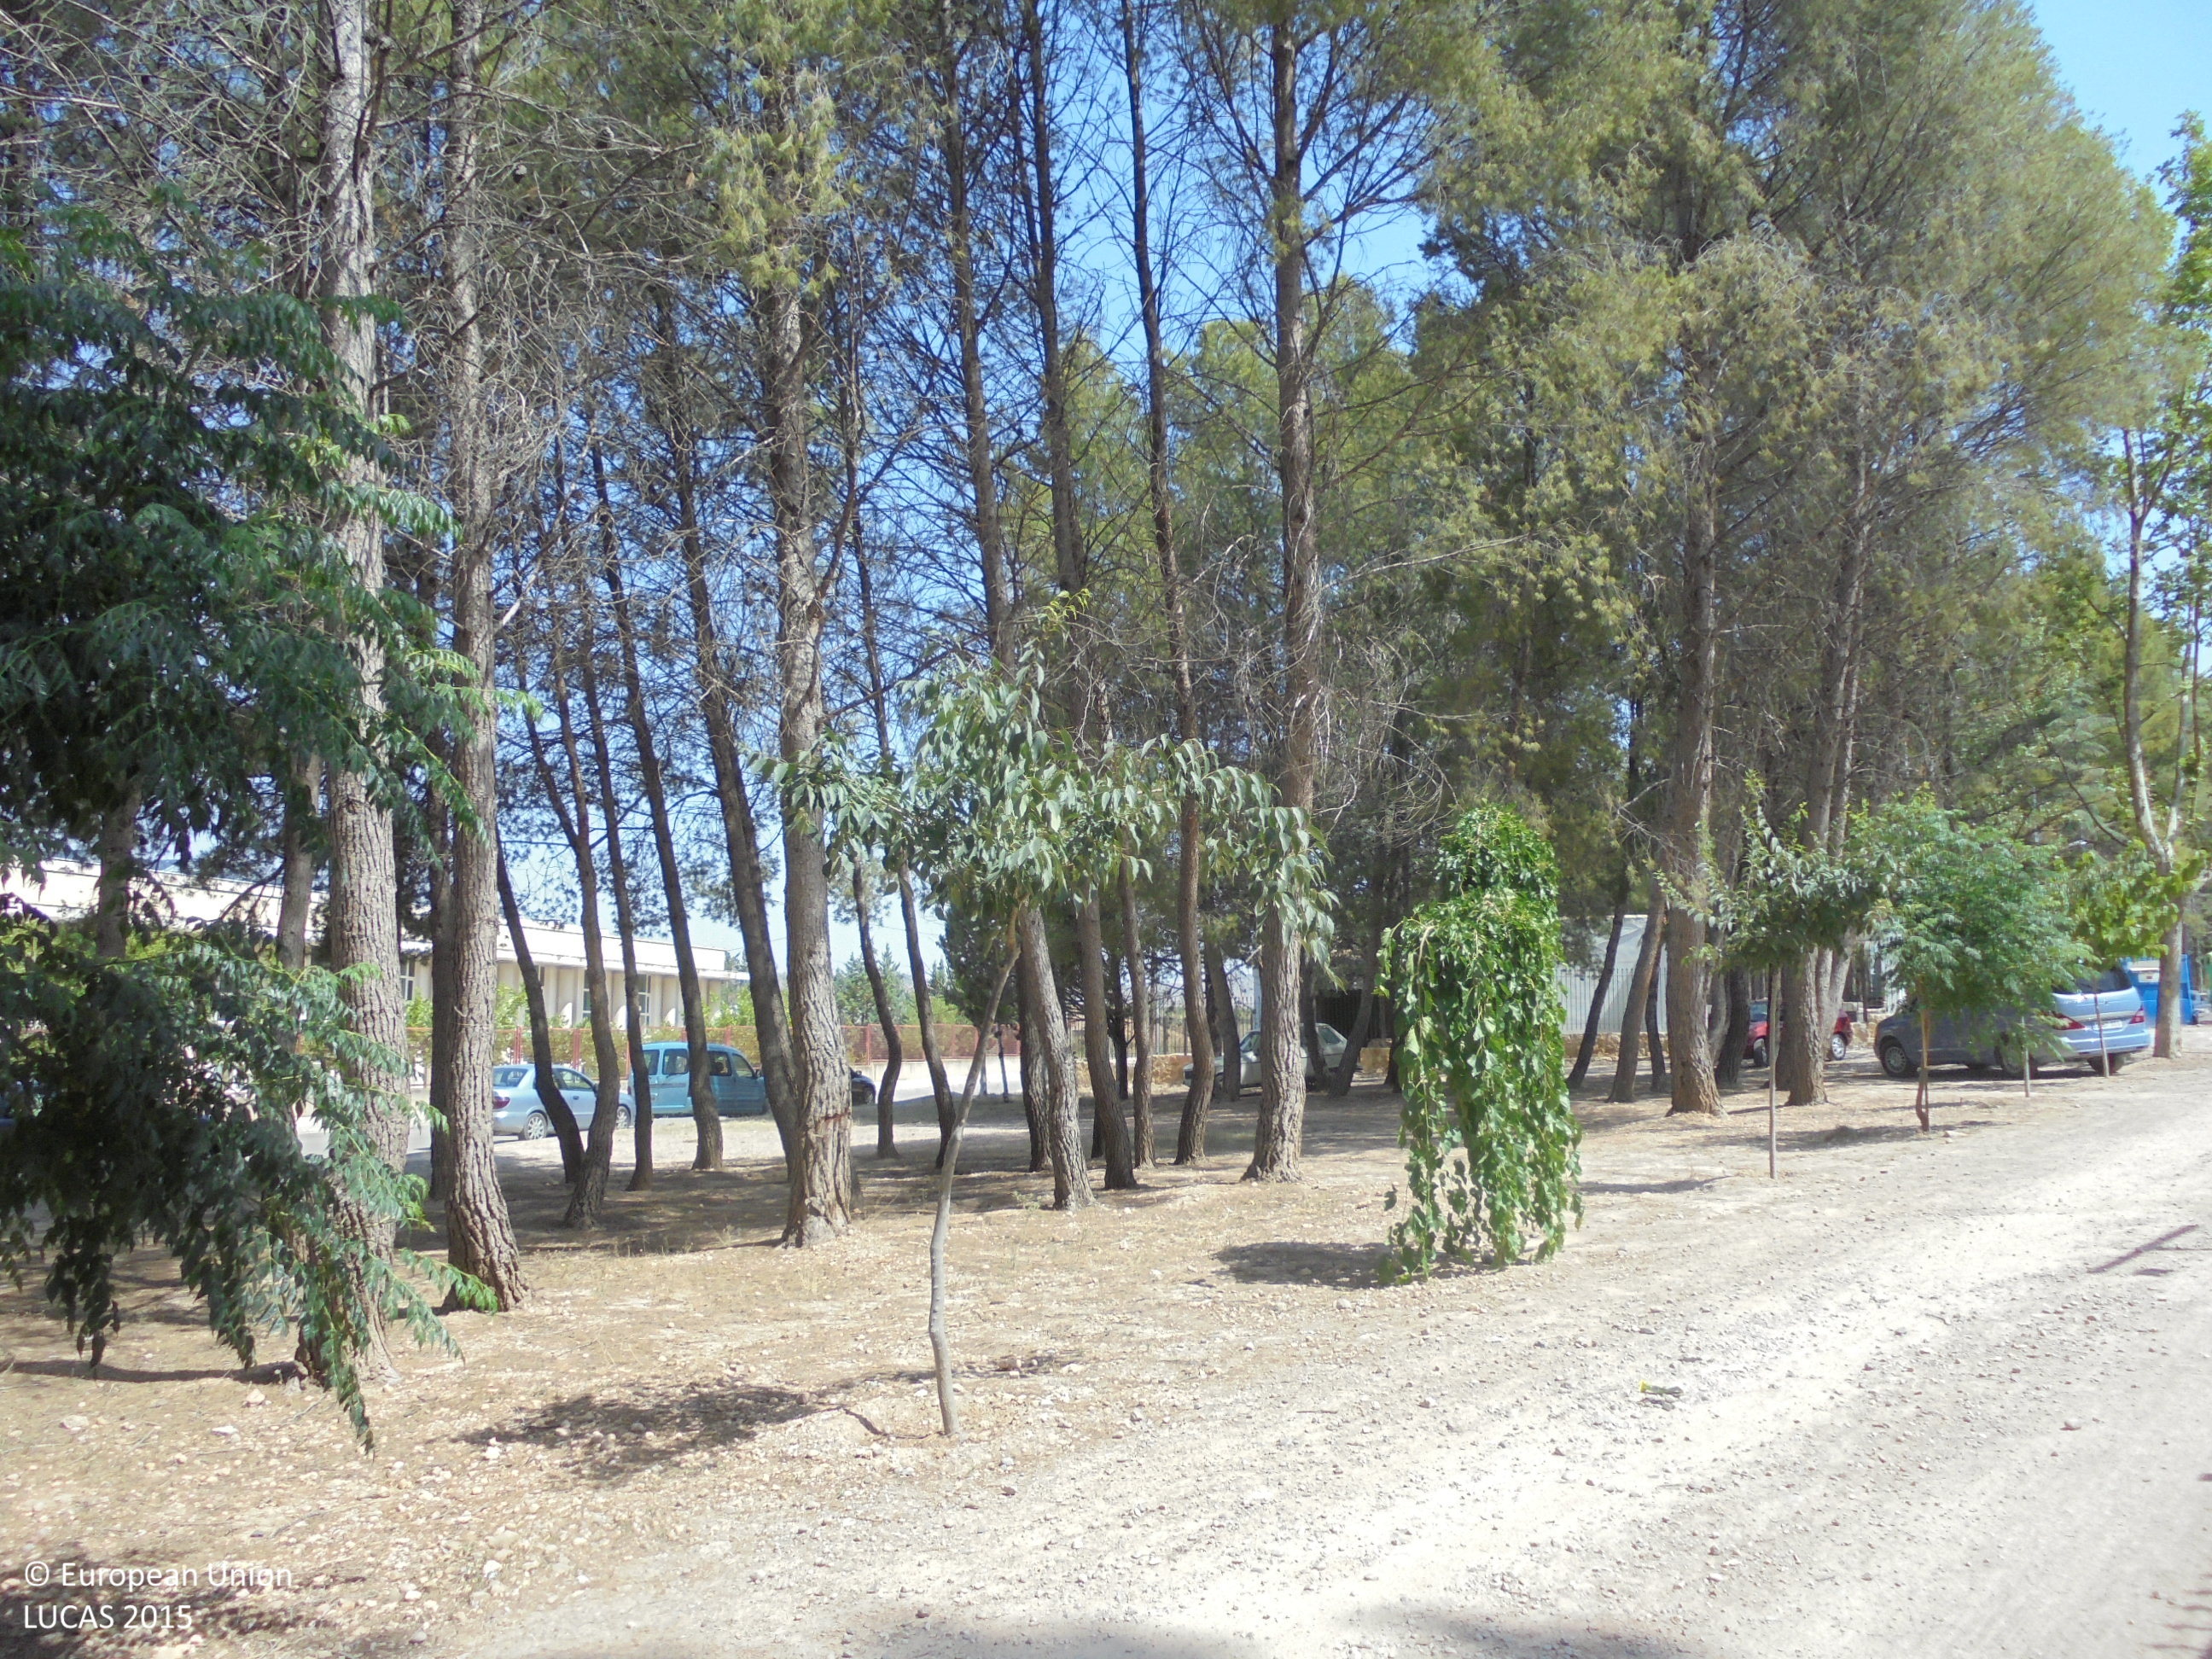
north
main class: Woodland
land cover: Pine dominated coniferous woodland
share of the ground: > 75 %
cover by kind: coniferous forest trees 100 %
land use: Amenities, museums, leisure
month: July
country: ES
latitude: 38.5969
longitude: -1.6943
